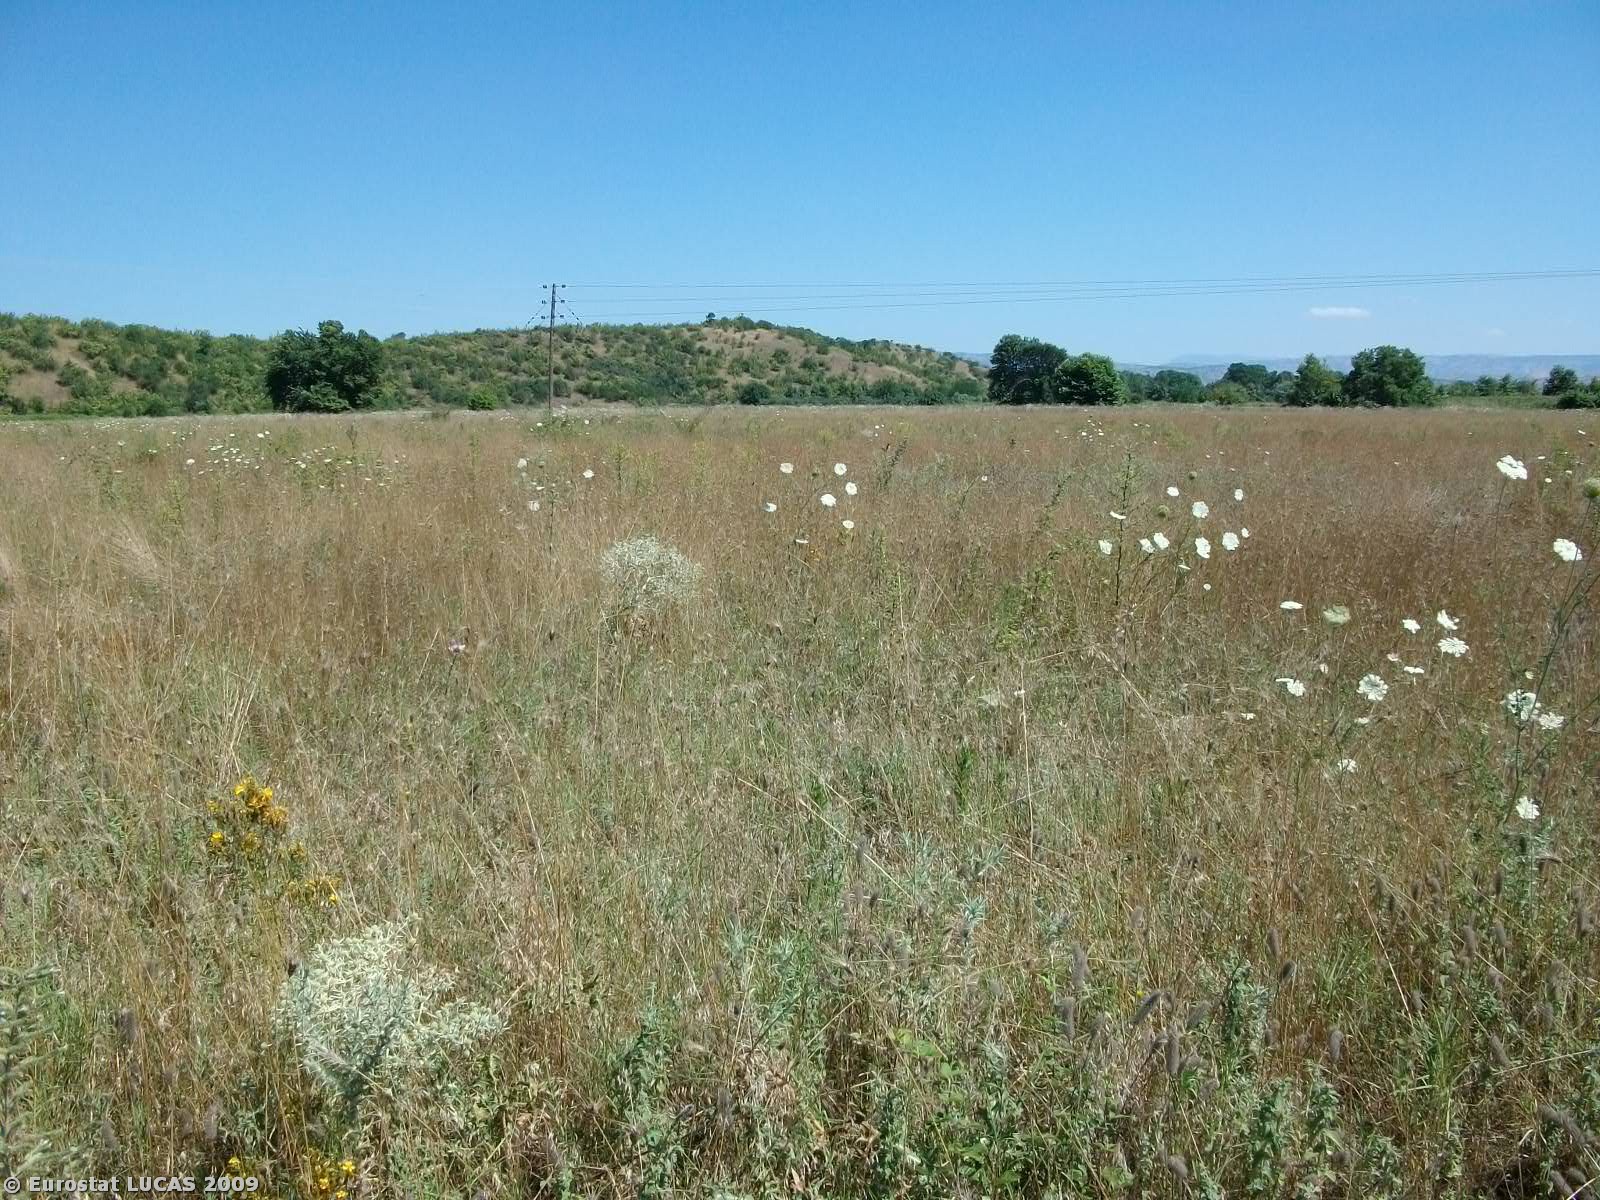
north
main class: Grassland
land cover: Grassland without tree/shrub cover
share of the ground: > 75 %
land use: Fallow land
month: July
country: GR
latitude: 39.5877
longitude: 21.6614
